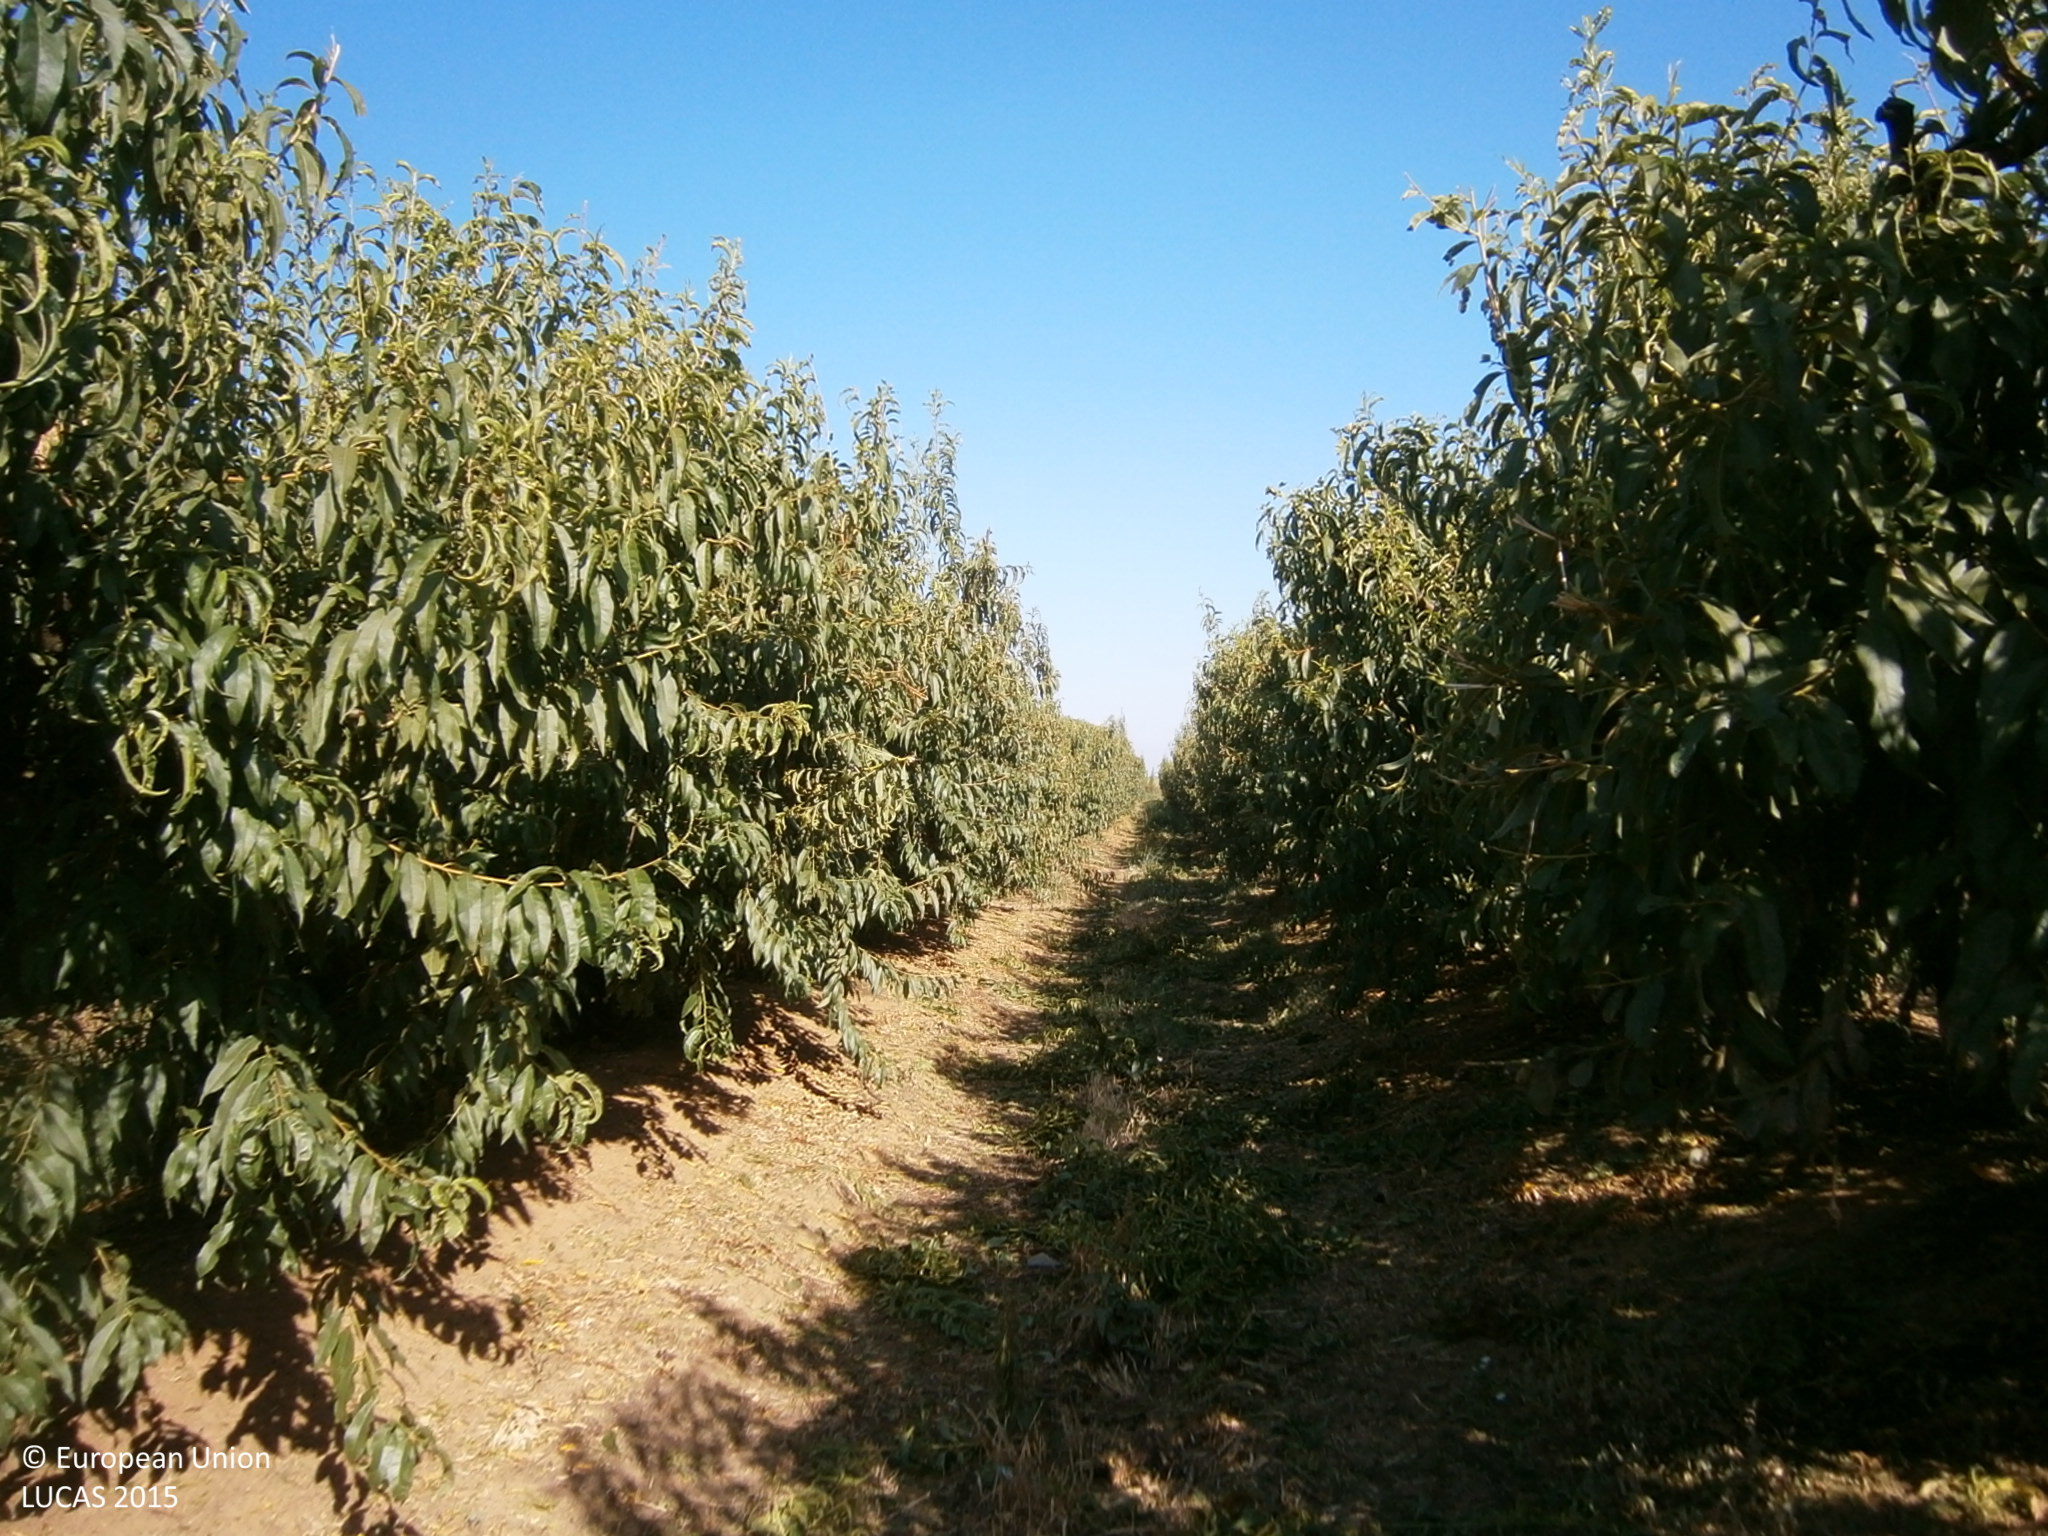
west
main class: Cropland
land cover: Other fruit trees and berries
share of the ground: 25 - 50 %
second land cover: Spontaneously vegetated surfaces
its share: 25 - 50 %
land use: Agriculture (excluding fallow land and kitchen gardens)
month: July
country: ES
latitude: 38.9326
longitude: -6.9235
